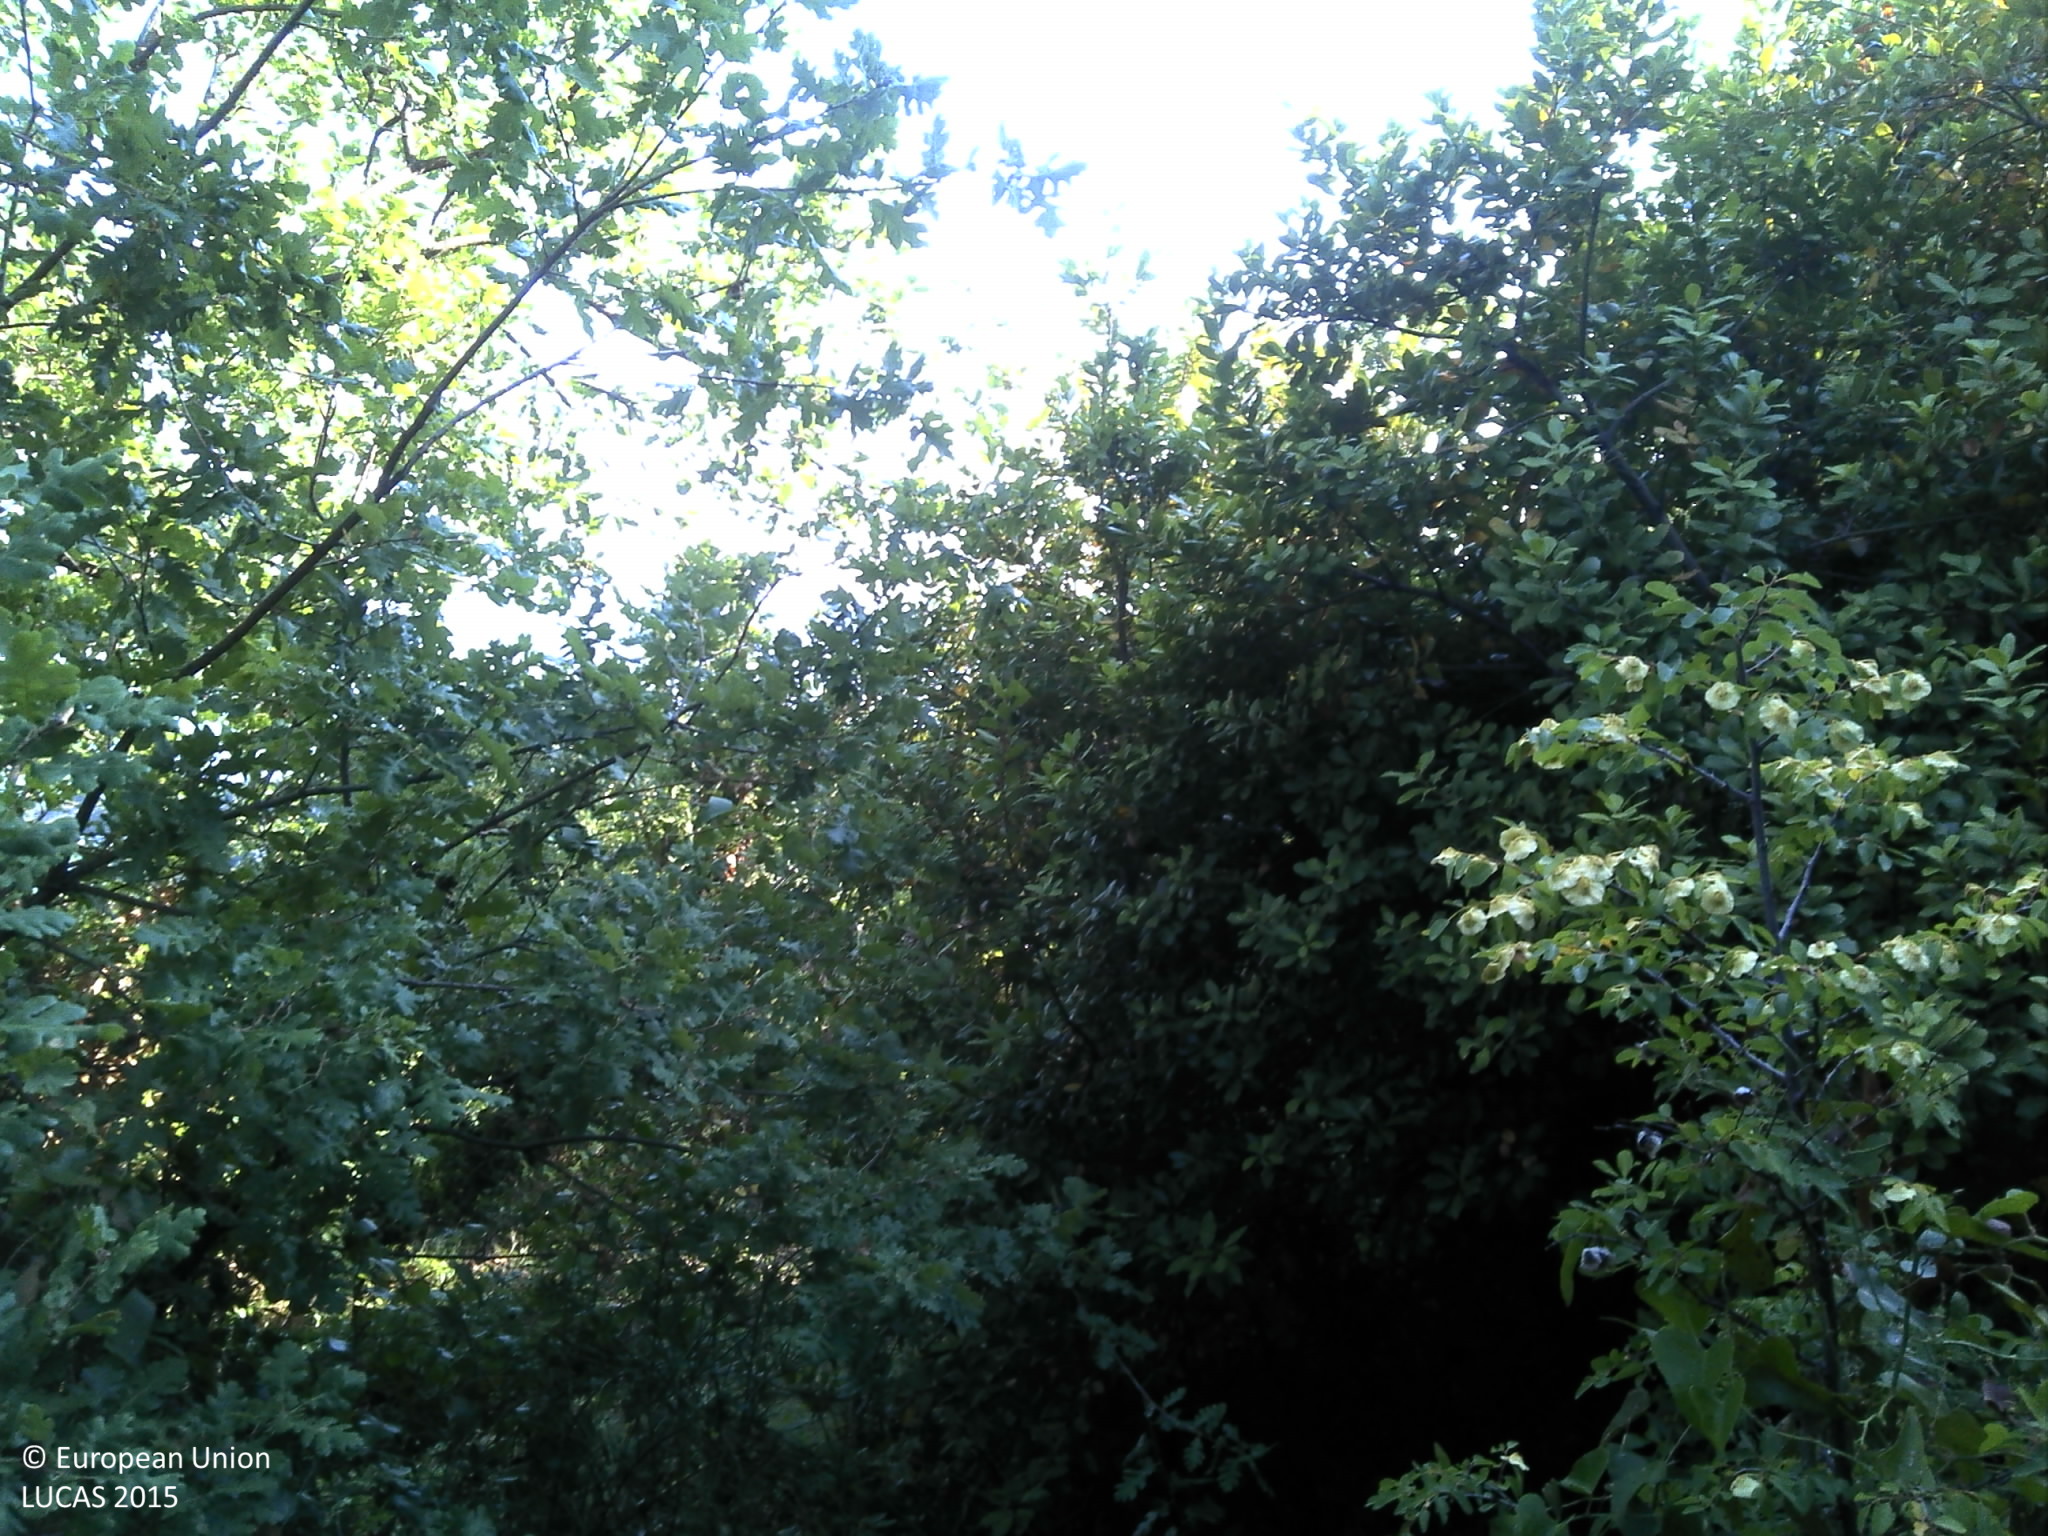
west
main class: Shrubland
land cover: Shrubland with sparse tree cover
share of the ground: 50 - 75 %
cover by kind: shrubs 60 %, herbaceous plants 15 %, unconsolidated bare surface 15 %, broadleaved forest trees 5 %, consolidated bare surface 5 %
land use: Semi-natural and natural areas not in use
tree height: < 5 m
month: July
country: HR
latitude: 42.6298
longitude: 18.1968
